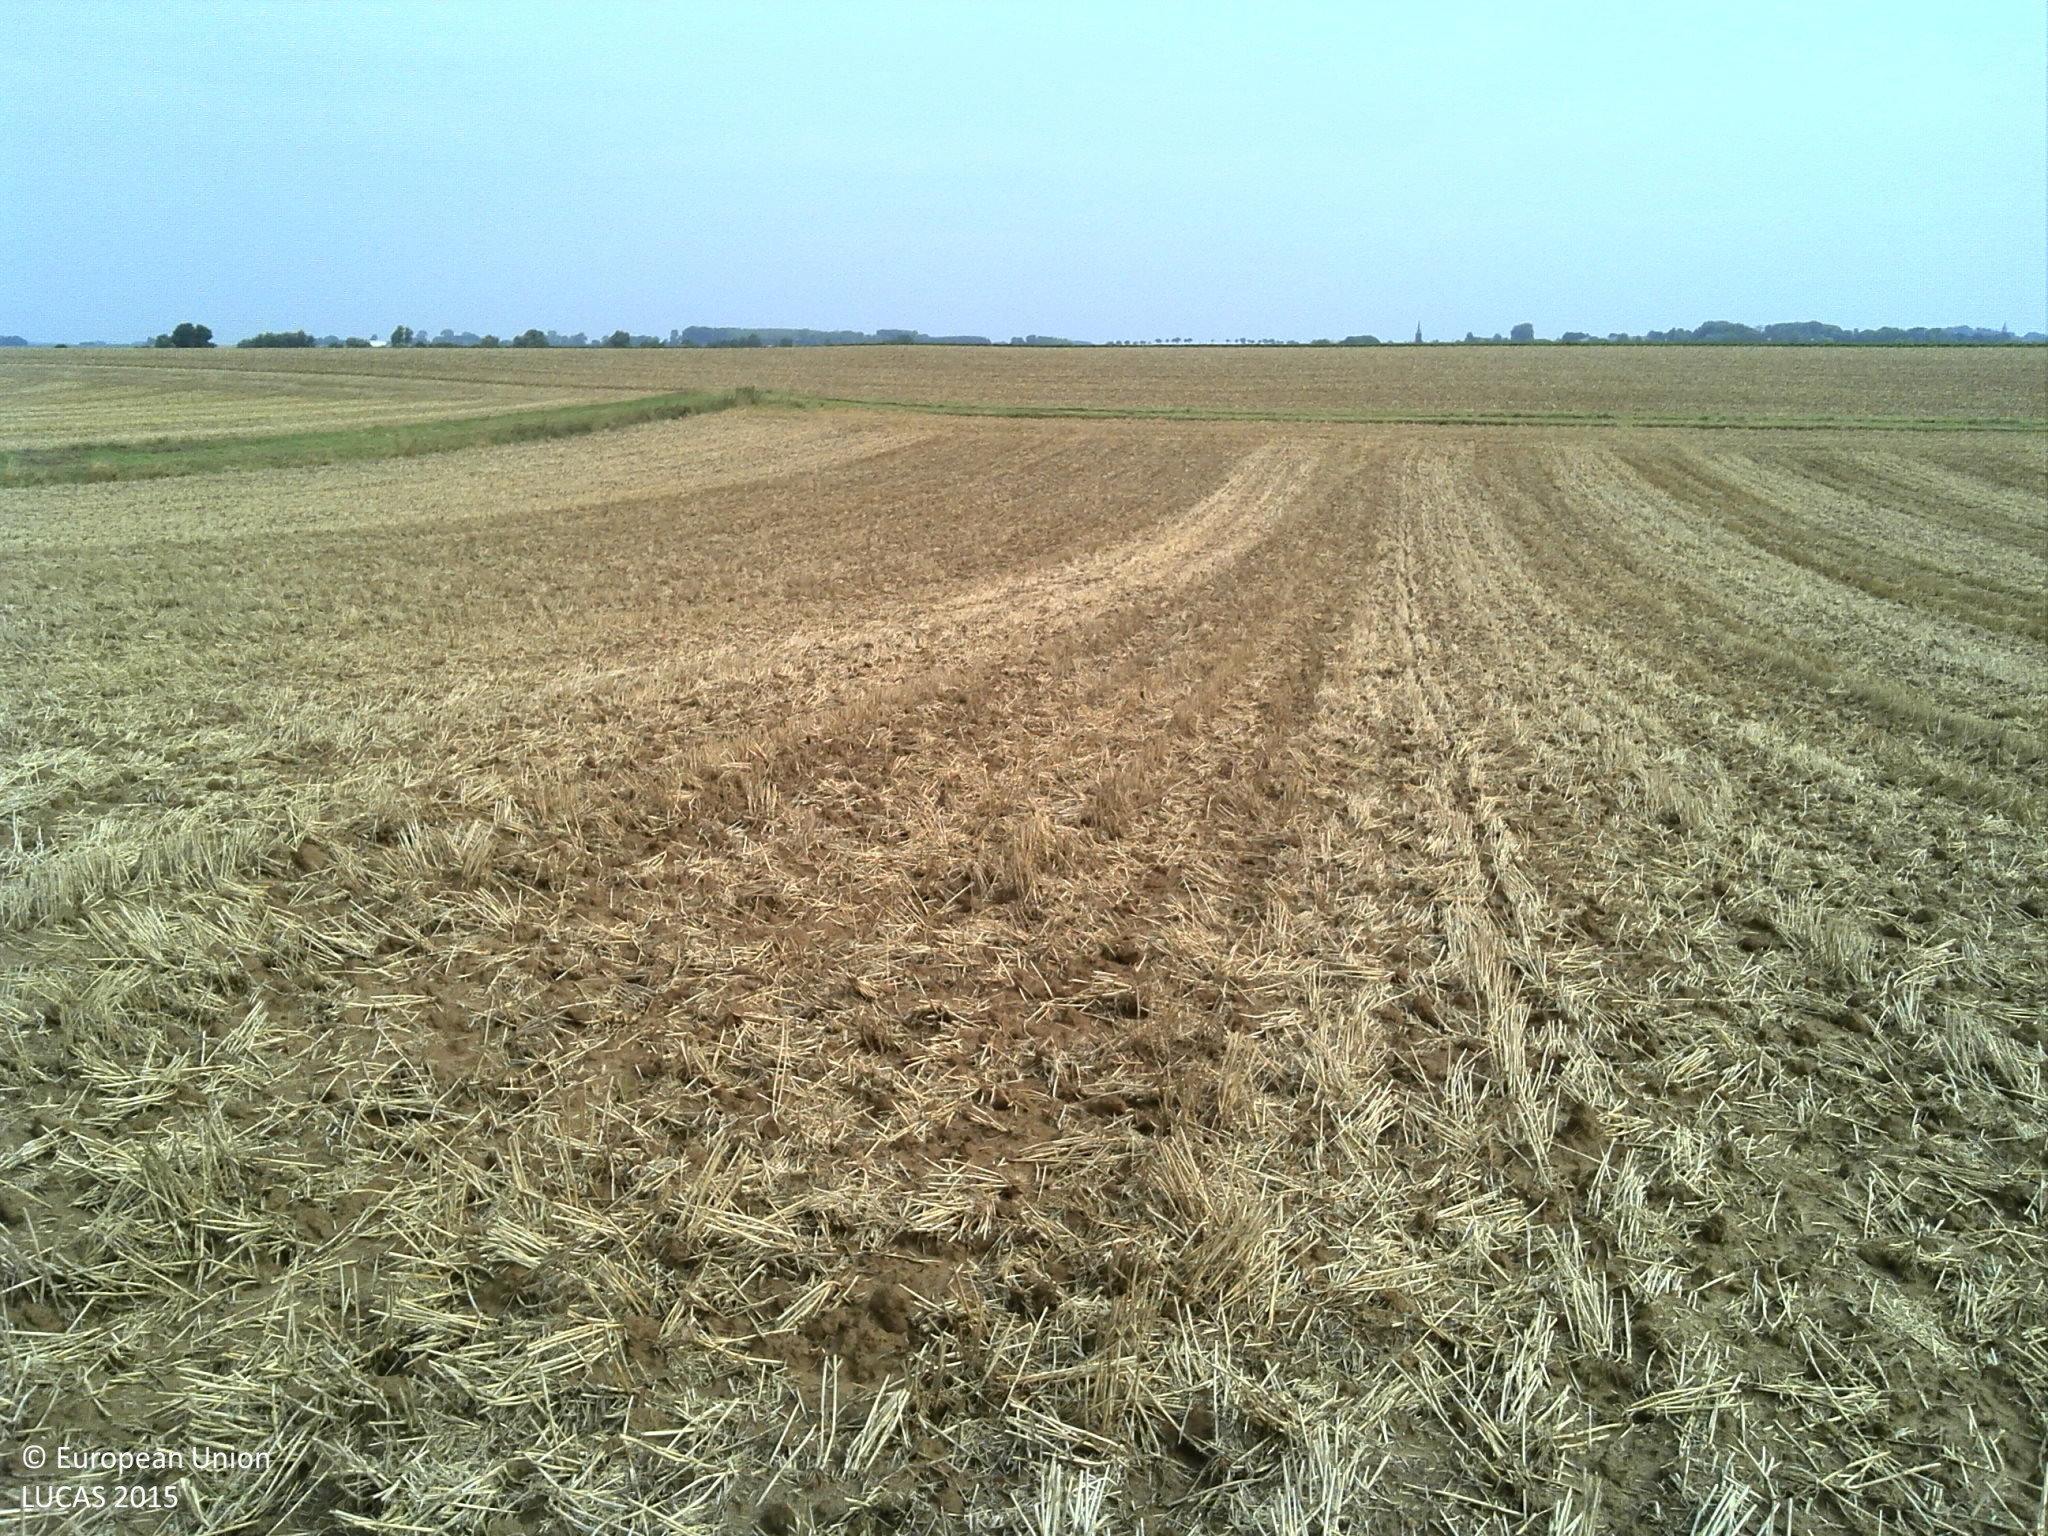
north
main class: Cropland
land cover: Common wheat
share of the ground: 25 - 50 %
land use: Agriculture (excluding fallow land and kitchen gardens)
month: August
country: FR
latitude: 50.0662
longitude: 2.8225
